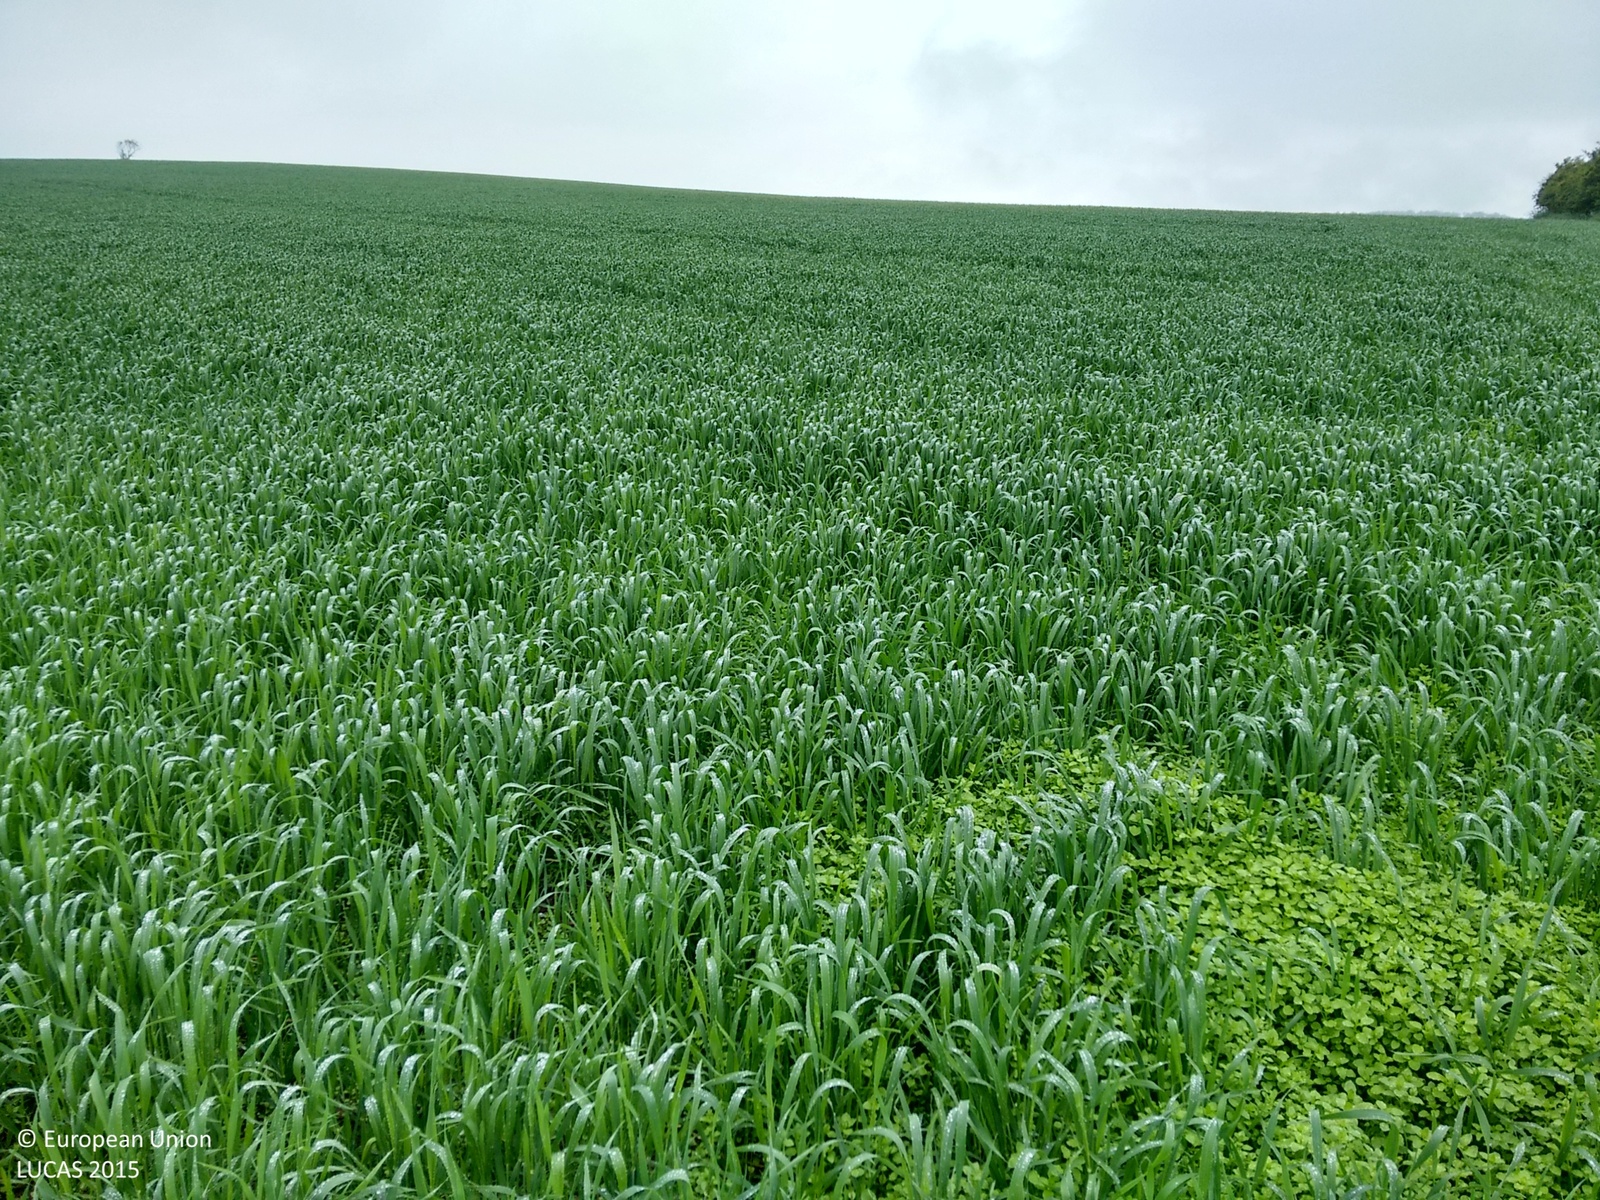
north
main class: Cropland
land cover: Barley
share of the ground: 50 - 75 %
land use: Agriculture (excluding fallow land and kitchen gardens)
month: June
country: GB
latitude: 55.0705
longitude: -3.3099
